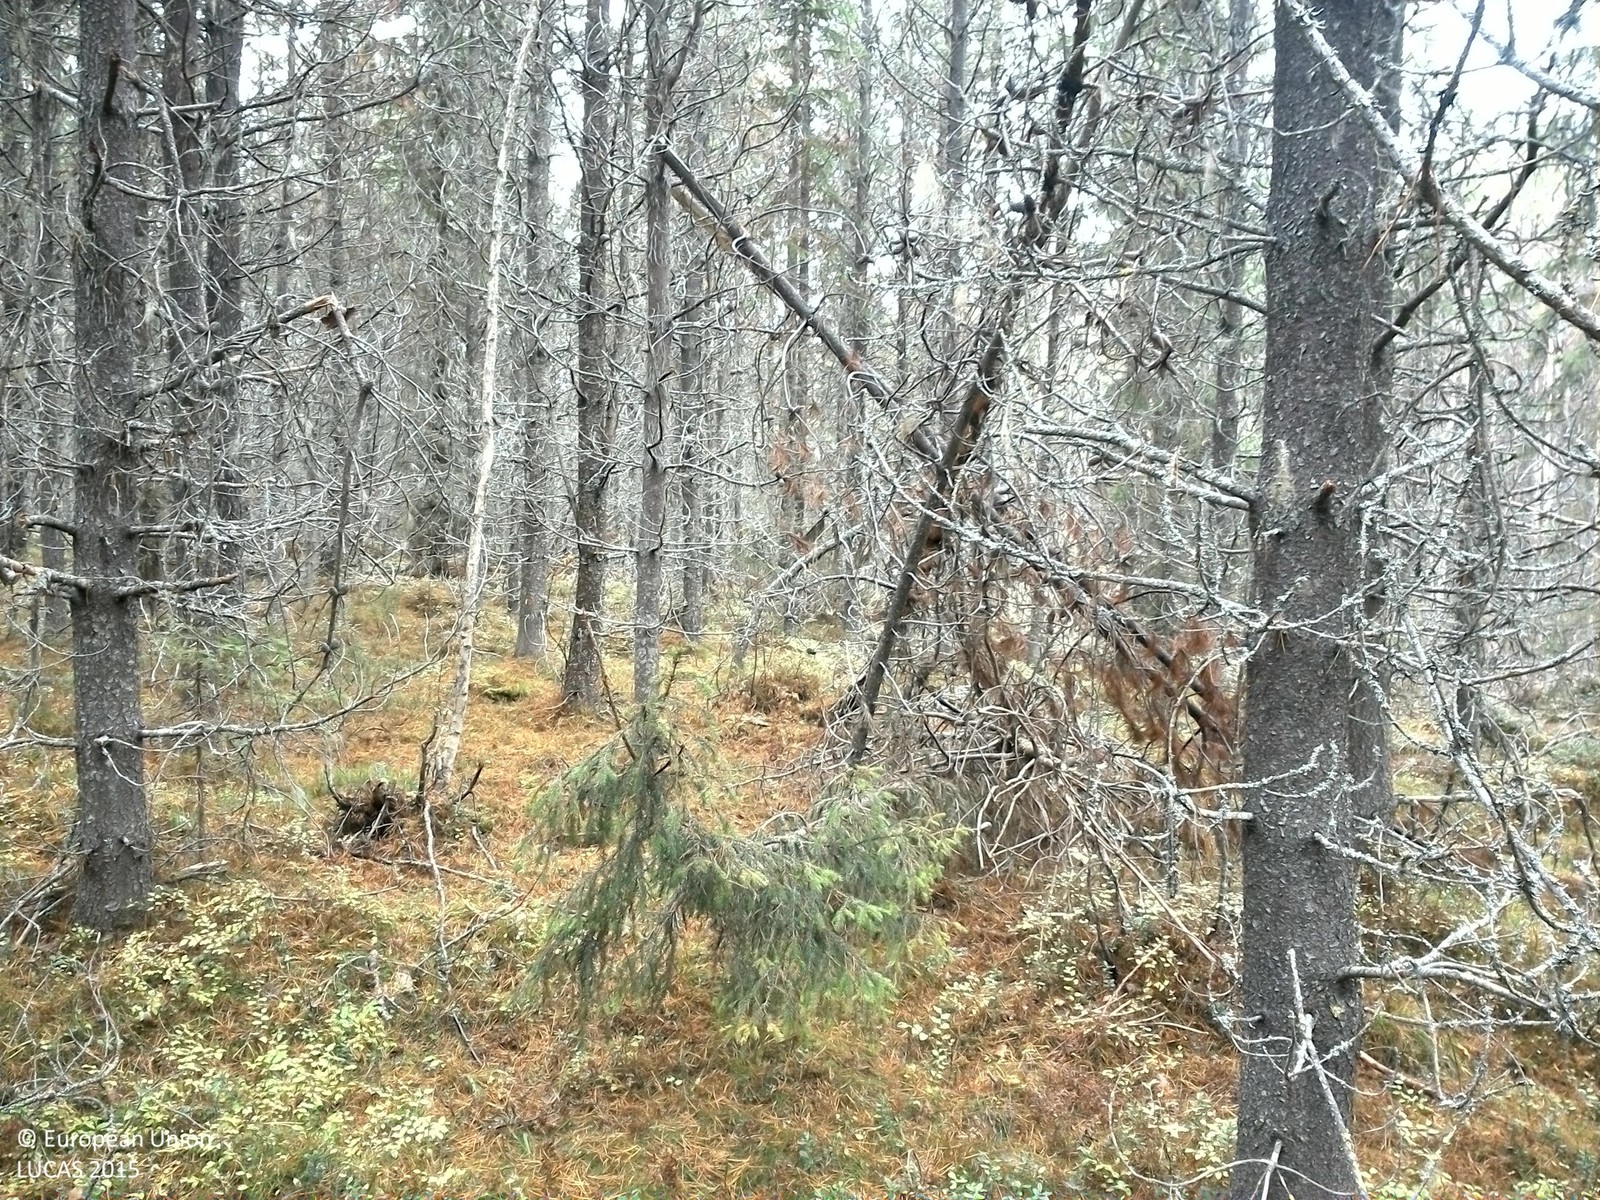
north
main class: Woodland
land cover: Pine dominated coniferous woodland
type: exotic forest
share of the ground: 50 - 75 %
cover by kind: coniferous forest trees 60 %, lichens and mosses 20 %, shrubs 10 %, herbaceous plants 10 %
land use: Forestry
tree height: > 5 m
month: October
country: SE
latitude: 64.1057
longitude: 15.9434
